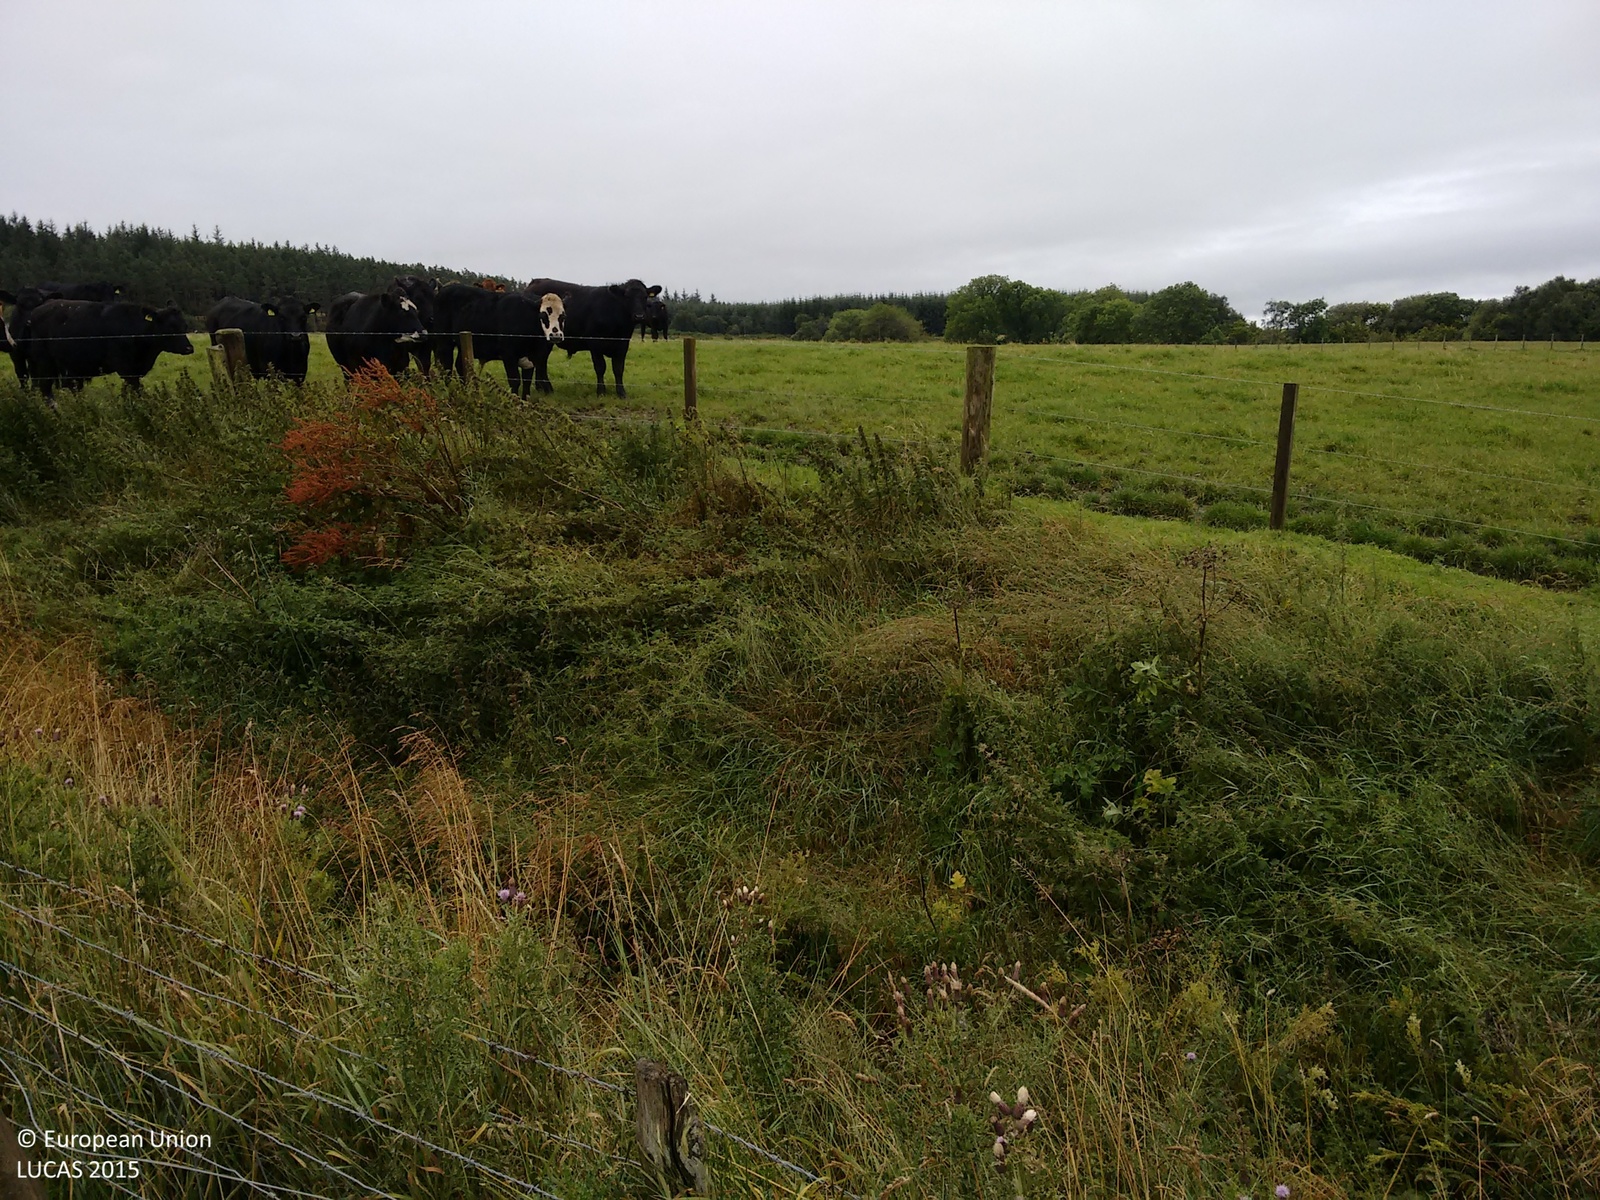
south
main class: Grassland
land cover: Grassland without tree/shrub cover
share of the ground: > 75 %
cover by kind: herbaceous plants 95 %, unconsolidated bare surface 5 %
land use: Agriculture (excluding fallow land and kitchen gardens)
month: September
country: GB
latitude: 57.5391
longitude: -2.9055
